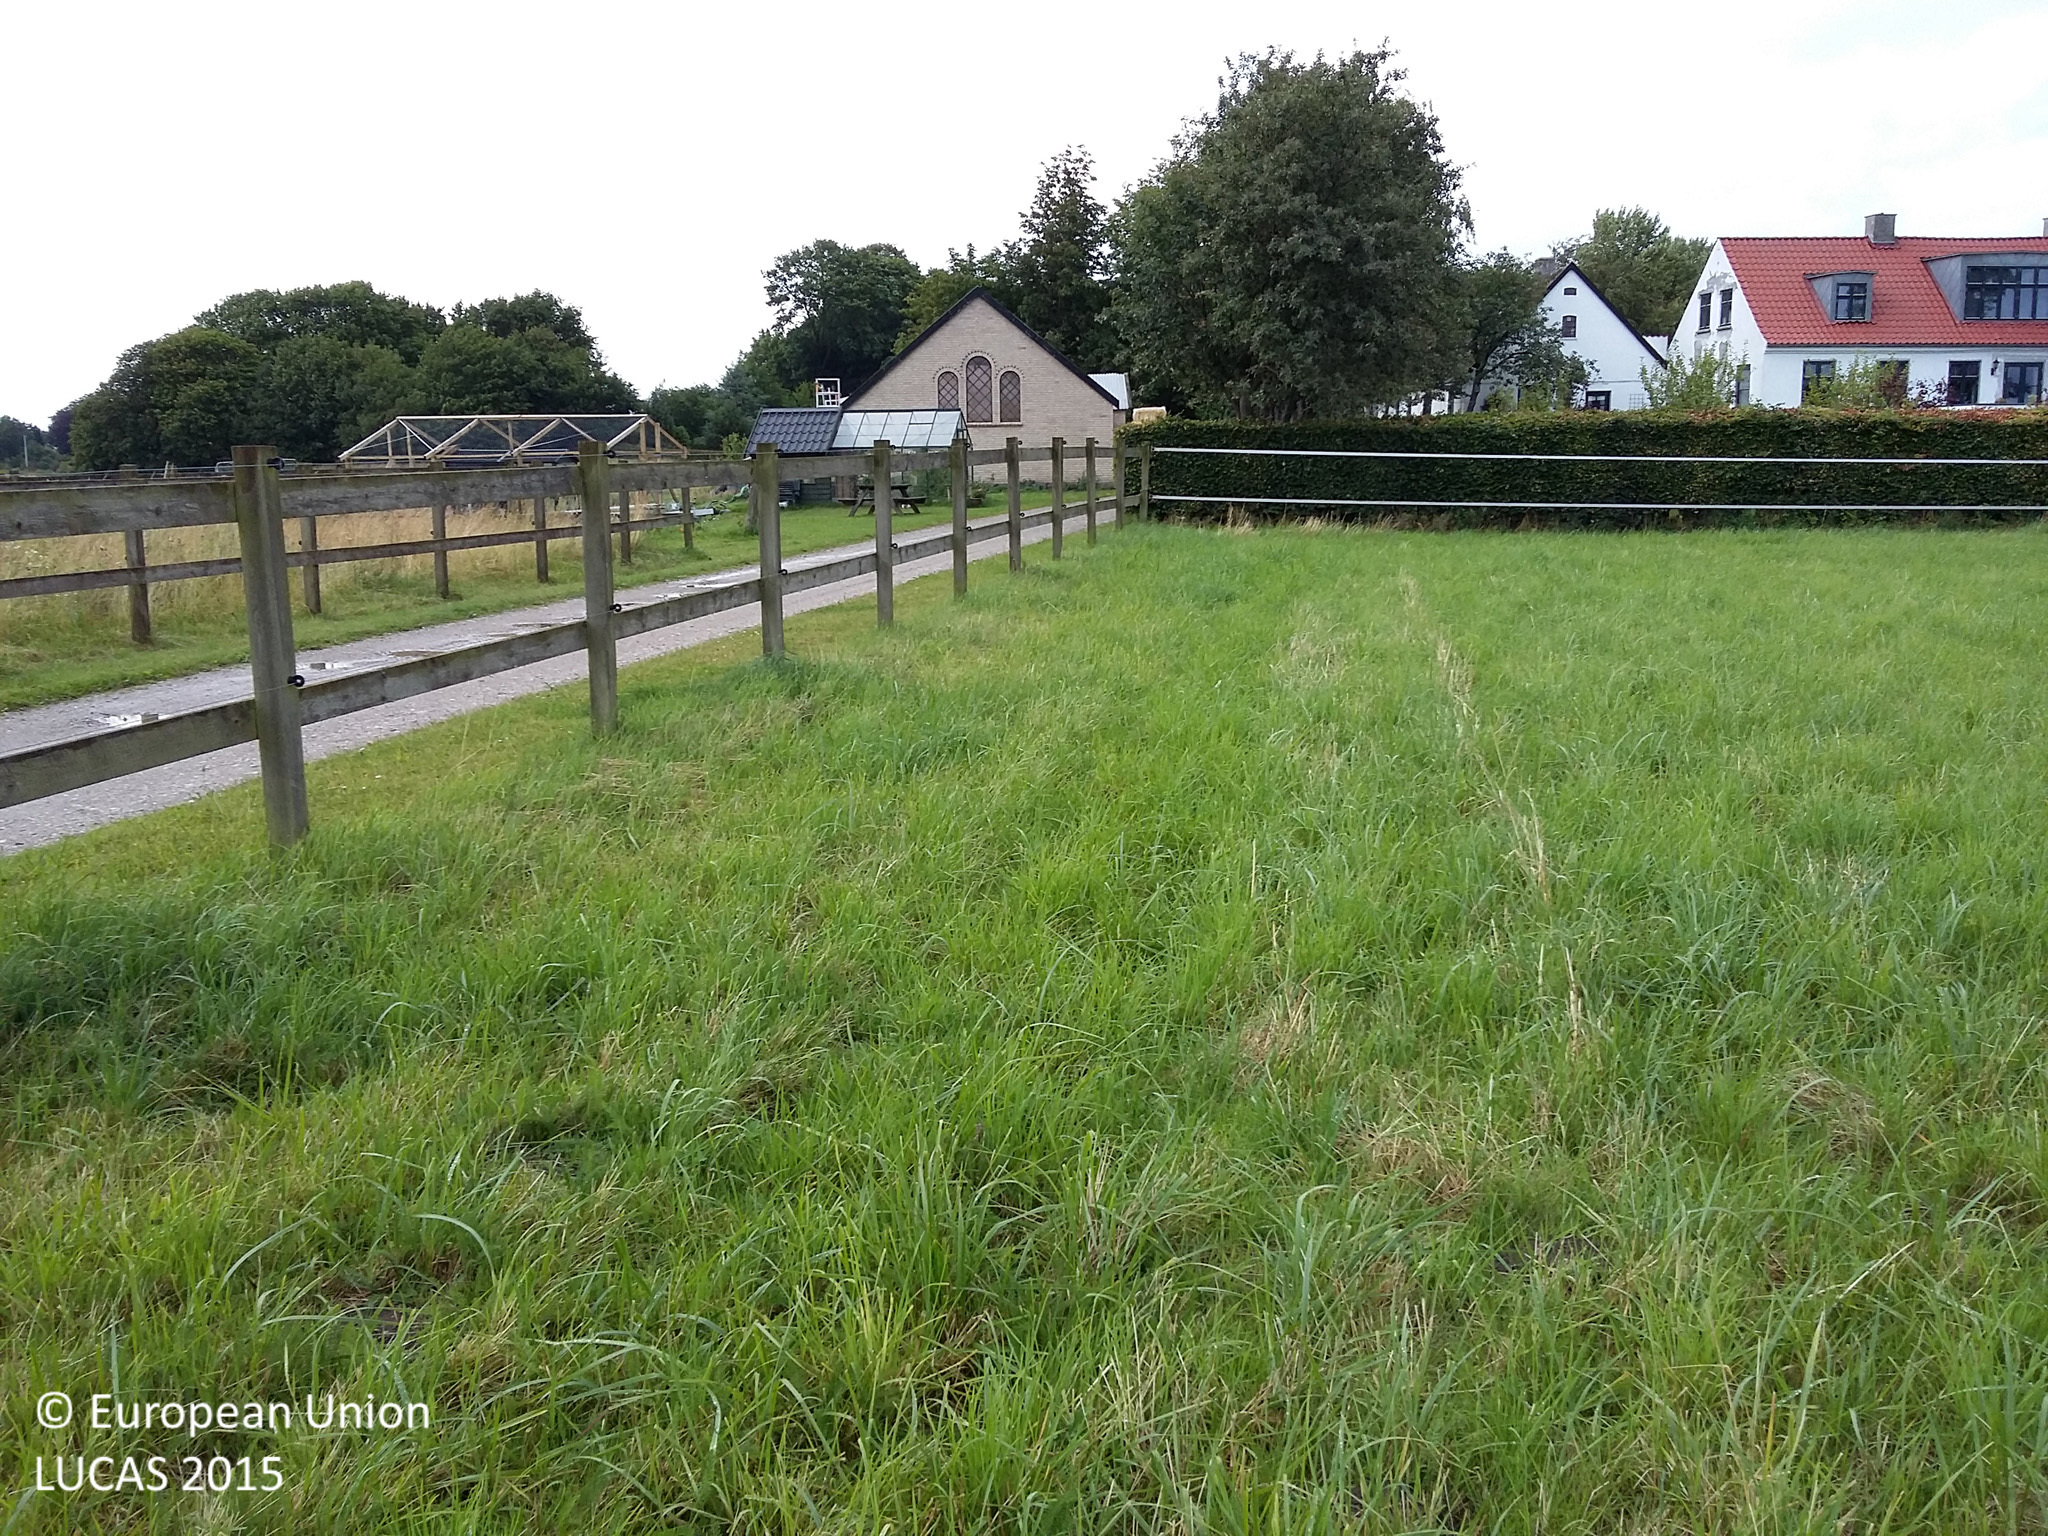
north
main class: Grassland
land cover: Grassland without tree/shrub cover
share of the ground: > 75 %
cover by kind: herbaceous plants 100 %
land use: Agriculture (excluding fallow land and kitchen gardens)
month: July
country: DK
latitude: 55.8280
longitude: 12.1532
